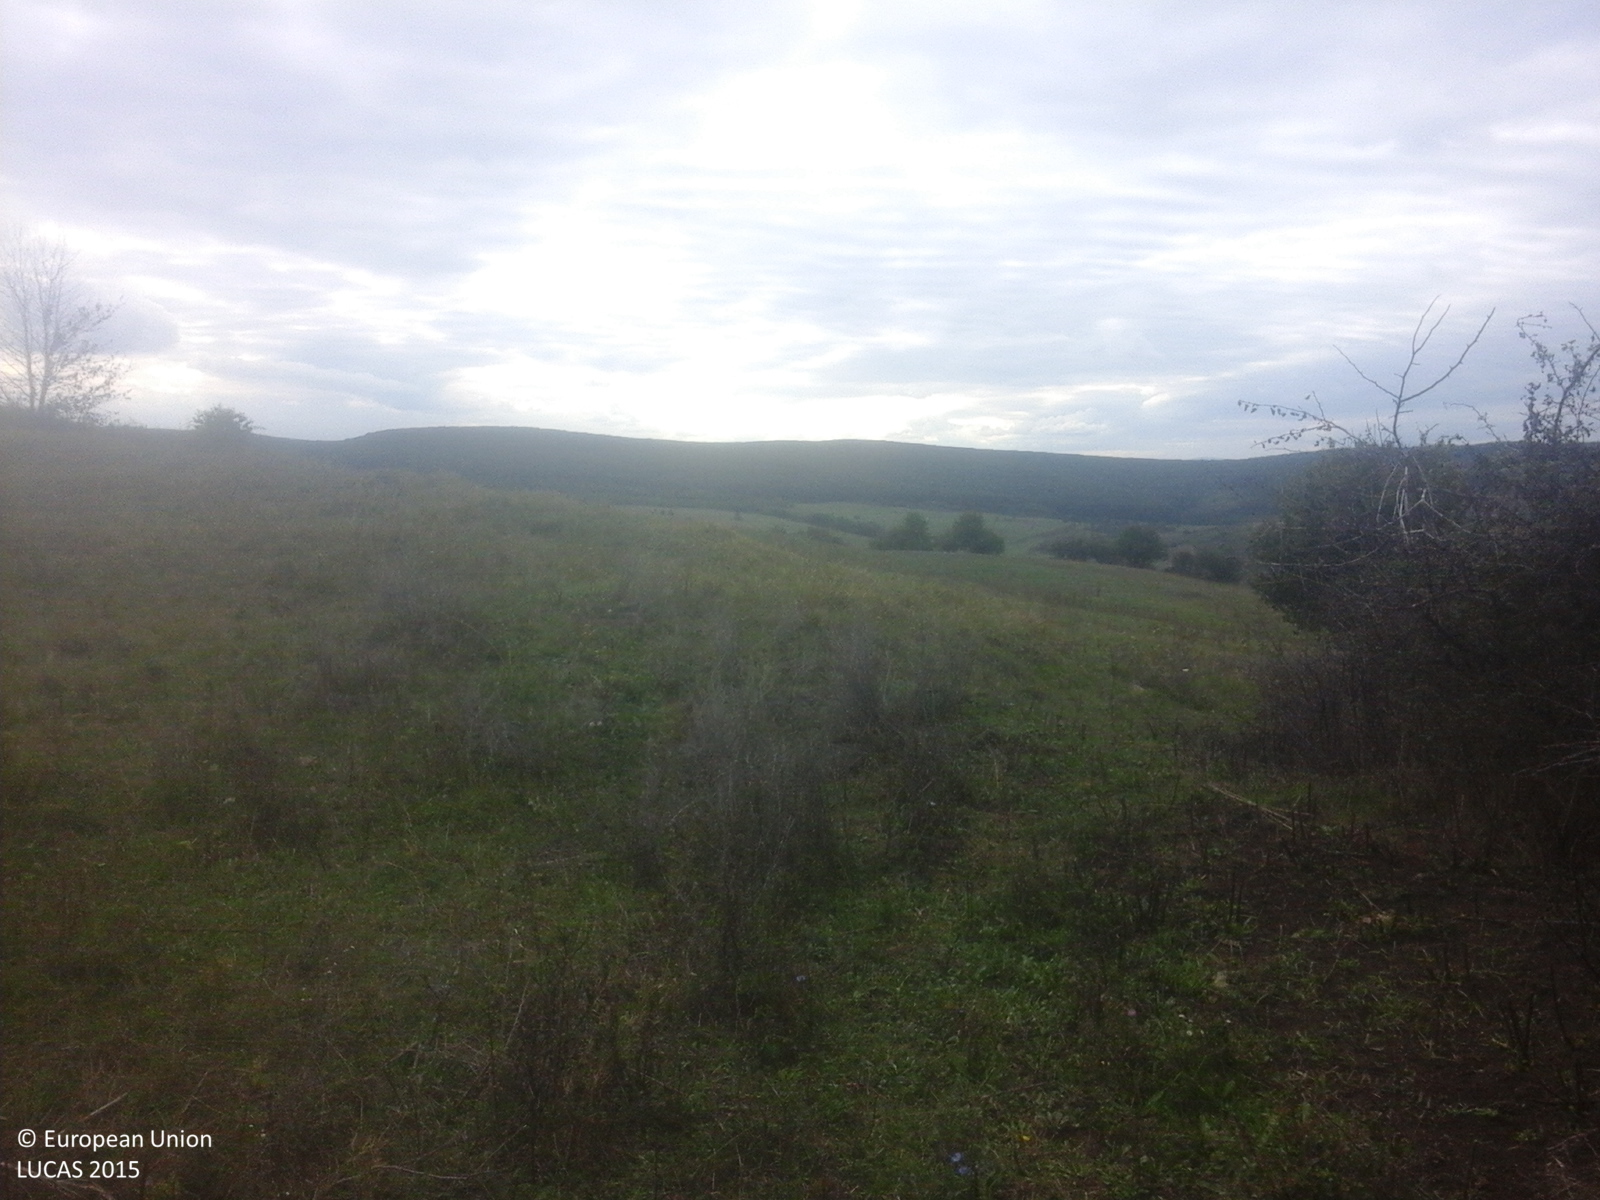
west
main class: Shrubland
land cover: Shrubland with sparse tree cover
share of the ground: > 75 %
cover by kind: shrubs 85 %, herbaceous plants 10 %, broadleaved forest trees 5 %
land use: Fallow land
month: September
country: RO
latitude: 45.9479
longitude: 23.9136
